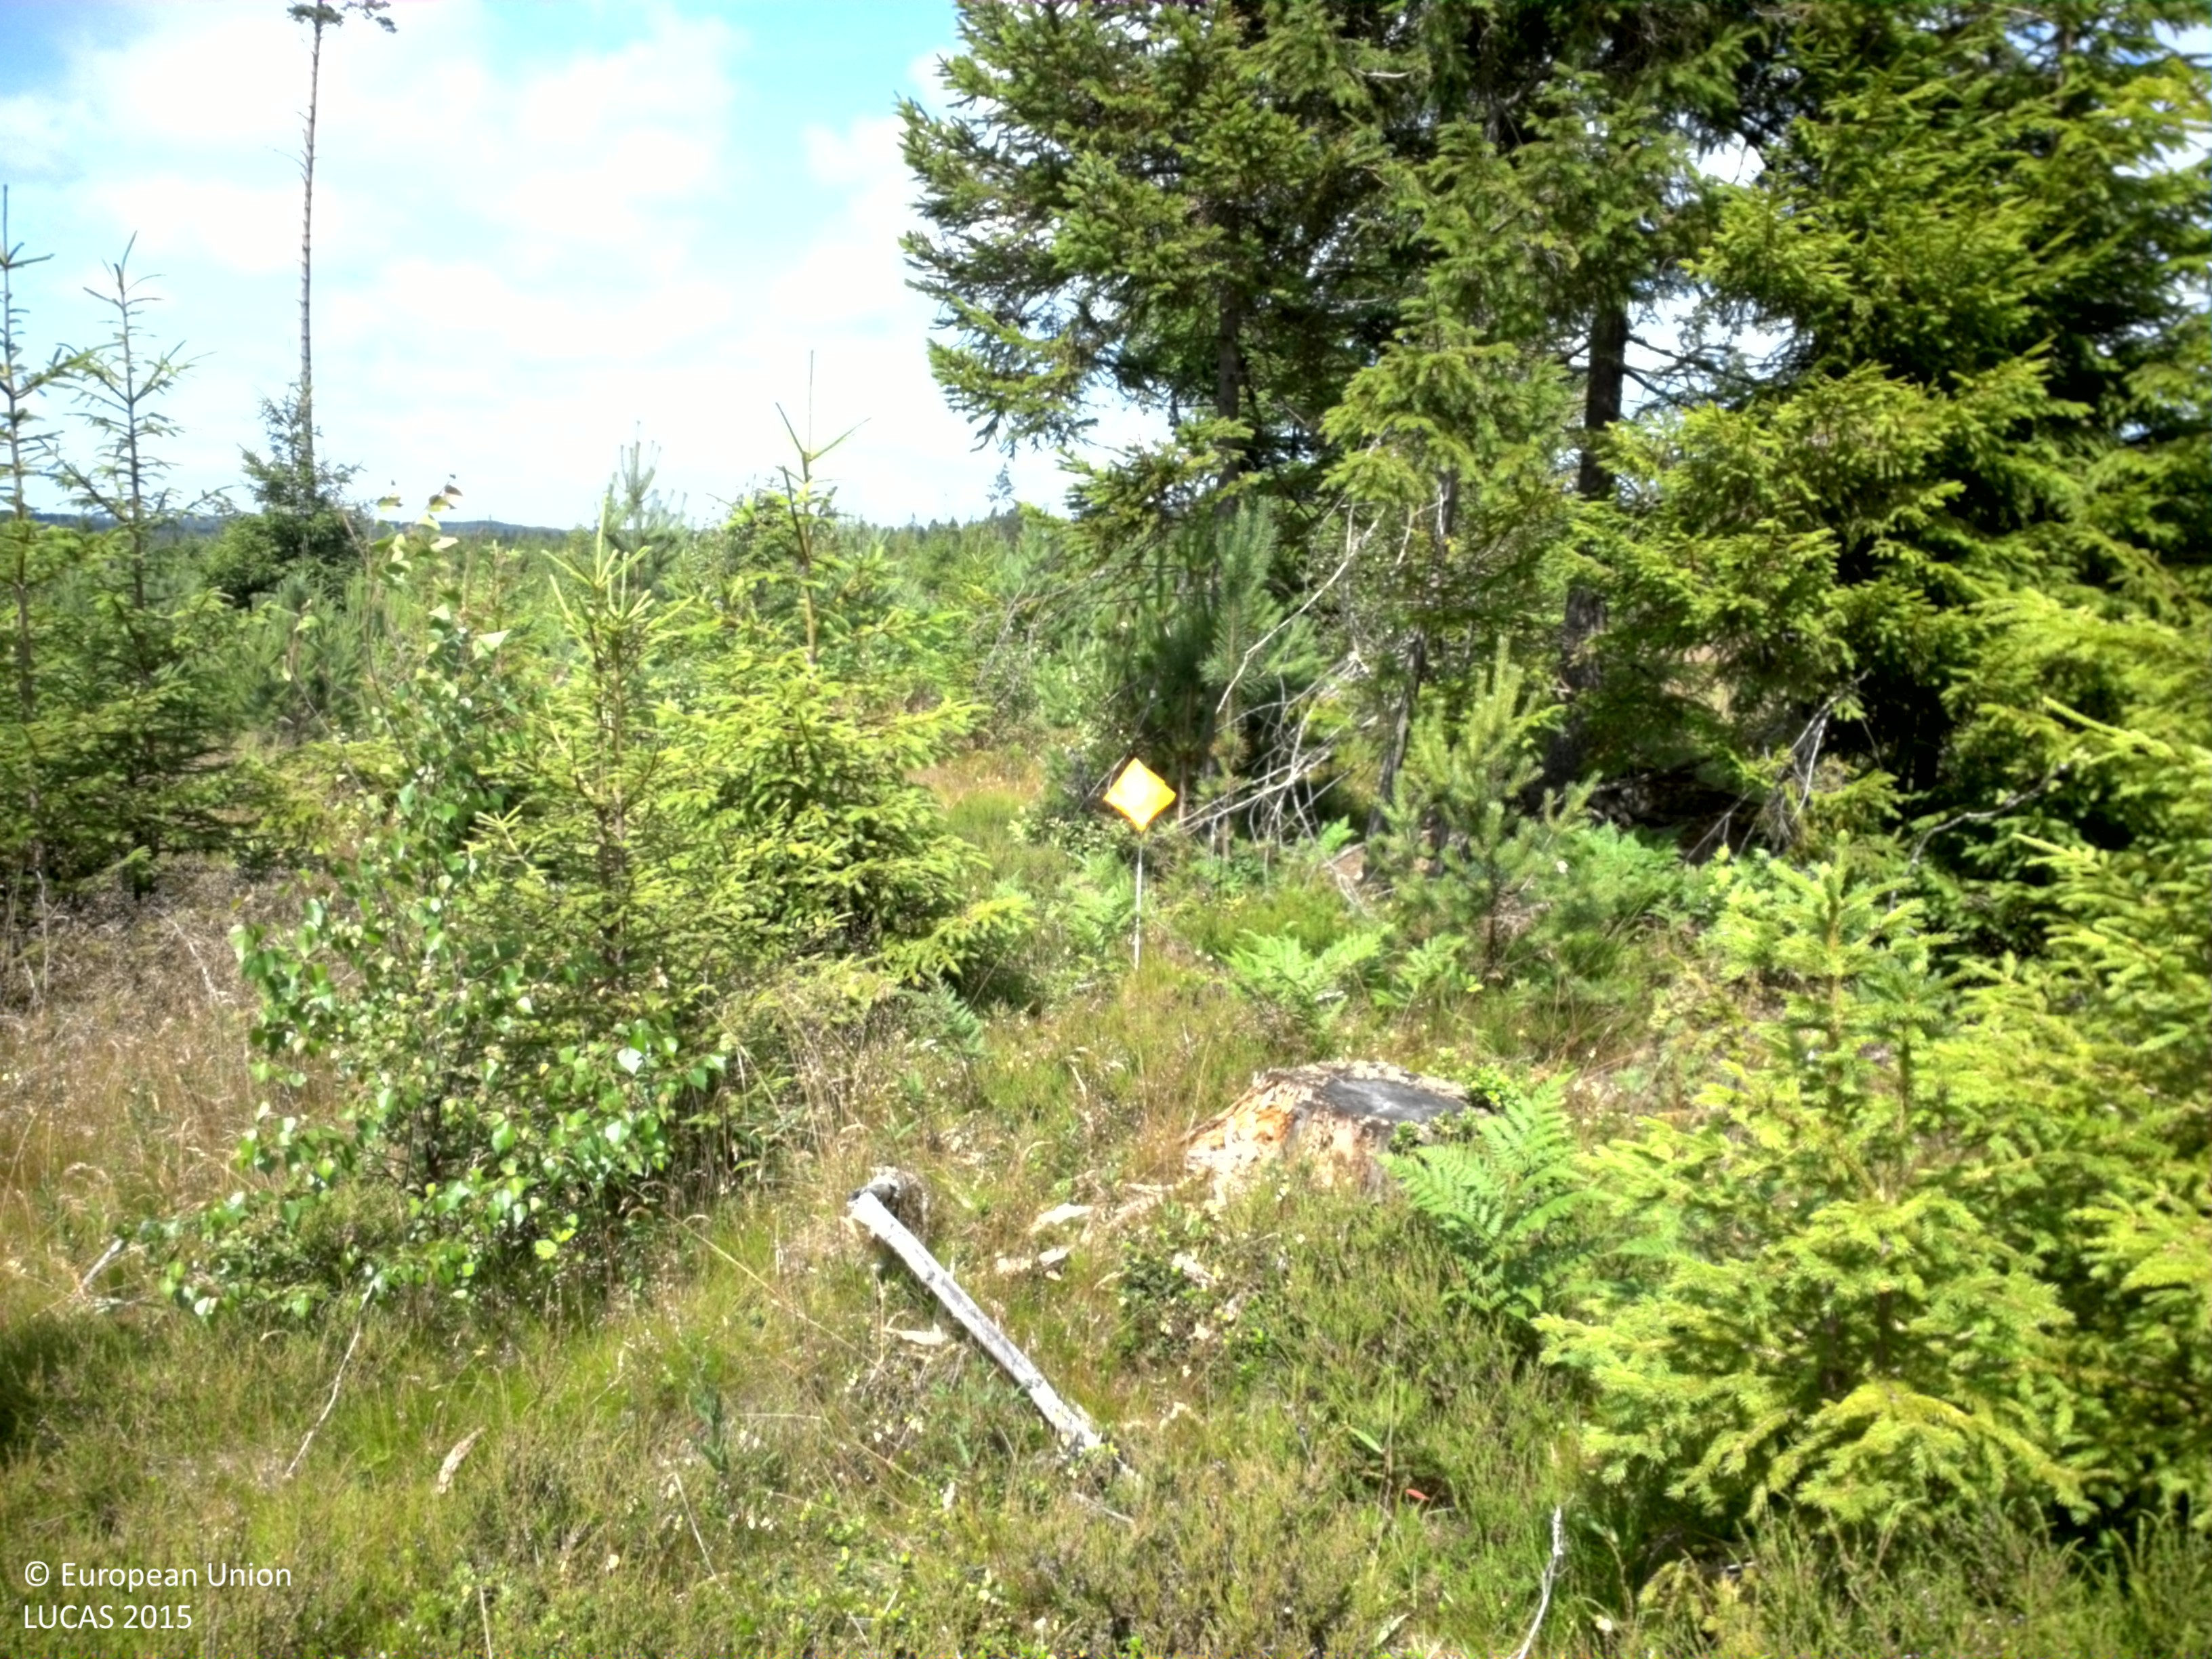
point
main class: Woodland
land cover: Other mixed woodland
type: boreal forest
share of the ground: 50 - 75 %
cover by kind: coniferous forest trees 40 %, broadleaved forest trees 20 %, herbaceous plants 20 %, shrubs 10 %, lichens and mosses 10 %
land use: Forestry
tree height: < 5 m
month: July
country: SE
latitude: 58.8633
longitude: 14.5527
